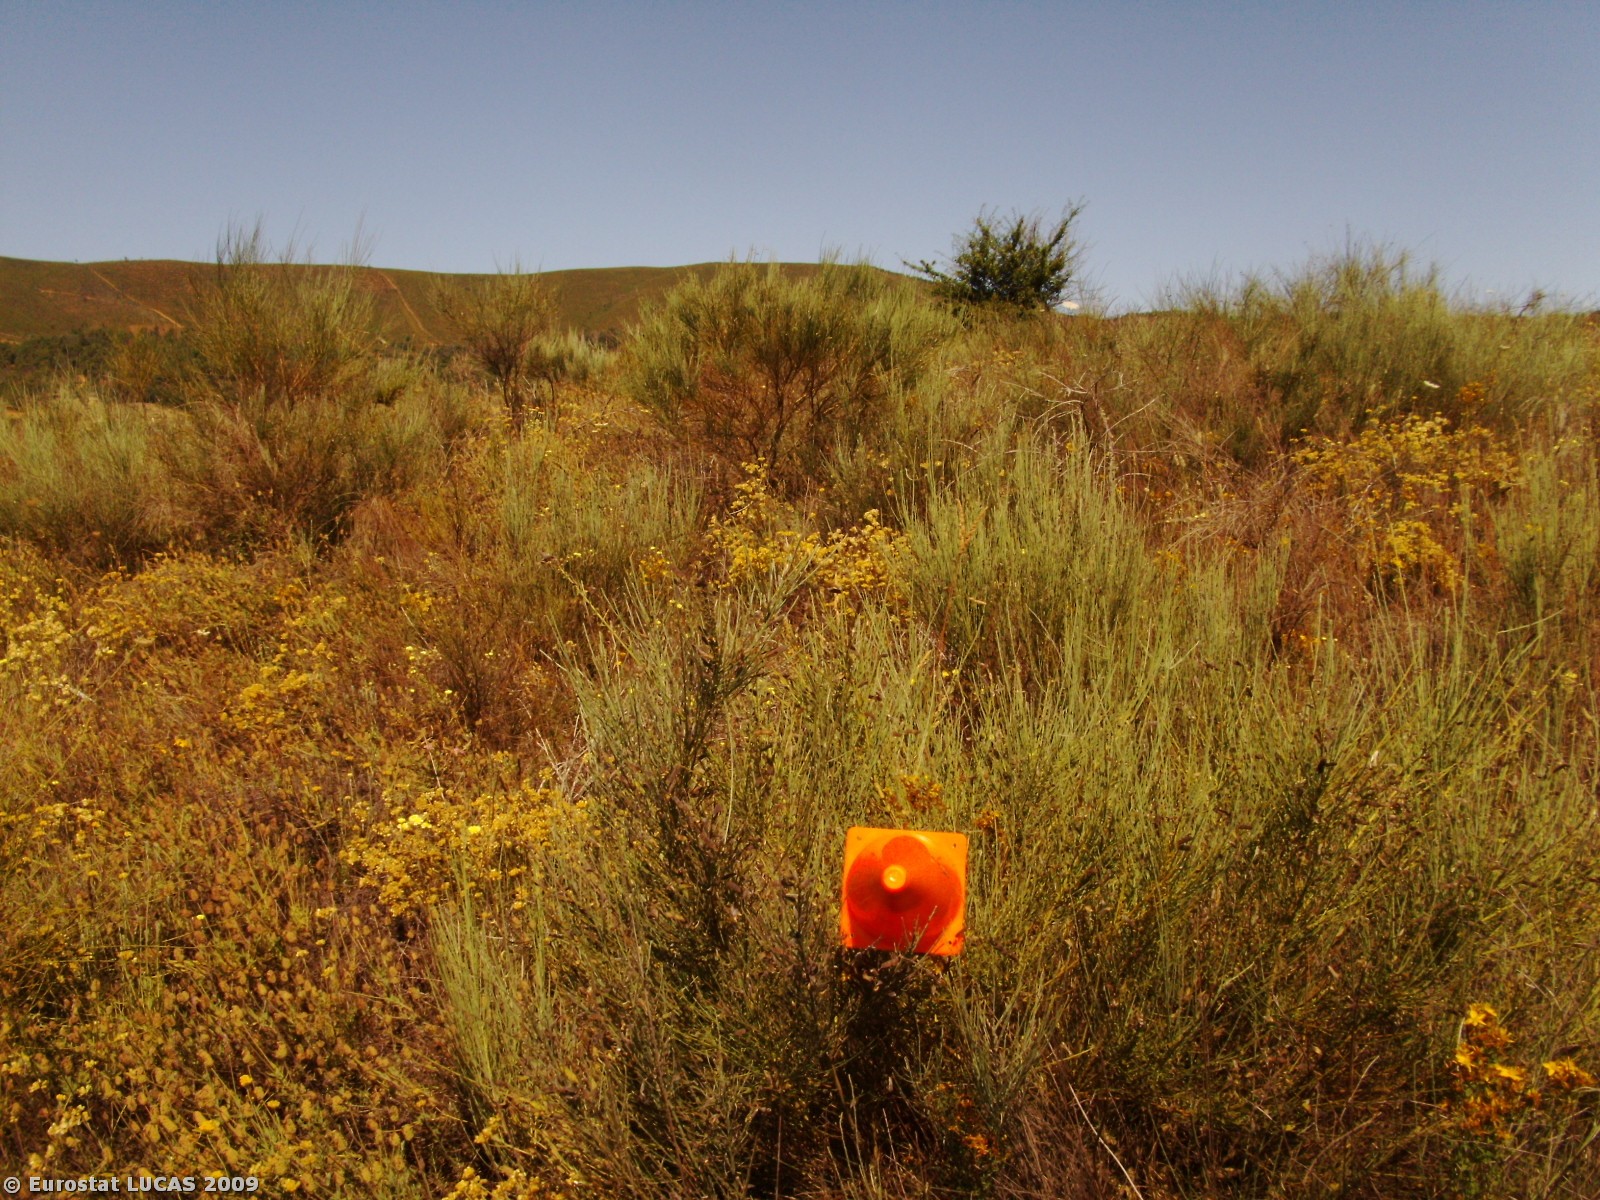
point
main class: Shrubland
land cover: Shrubland without tree cover
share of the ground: > 75 %
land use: Fallow land
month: June
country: PT
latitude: 40.1461
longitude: -7.5613
